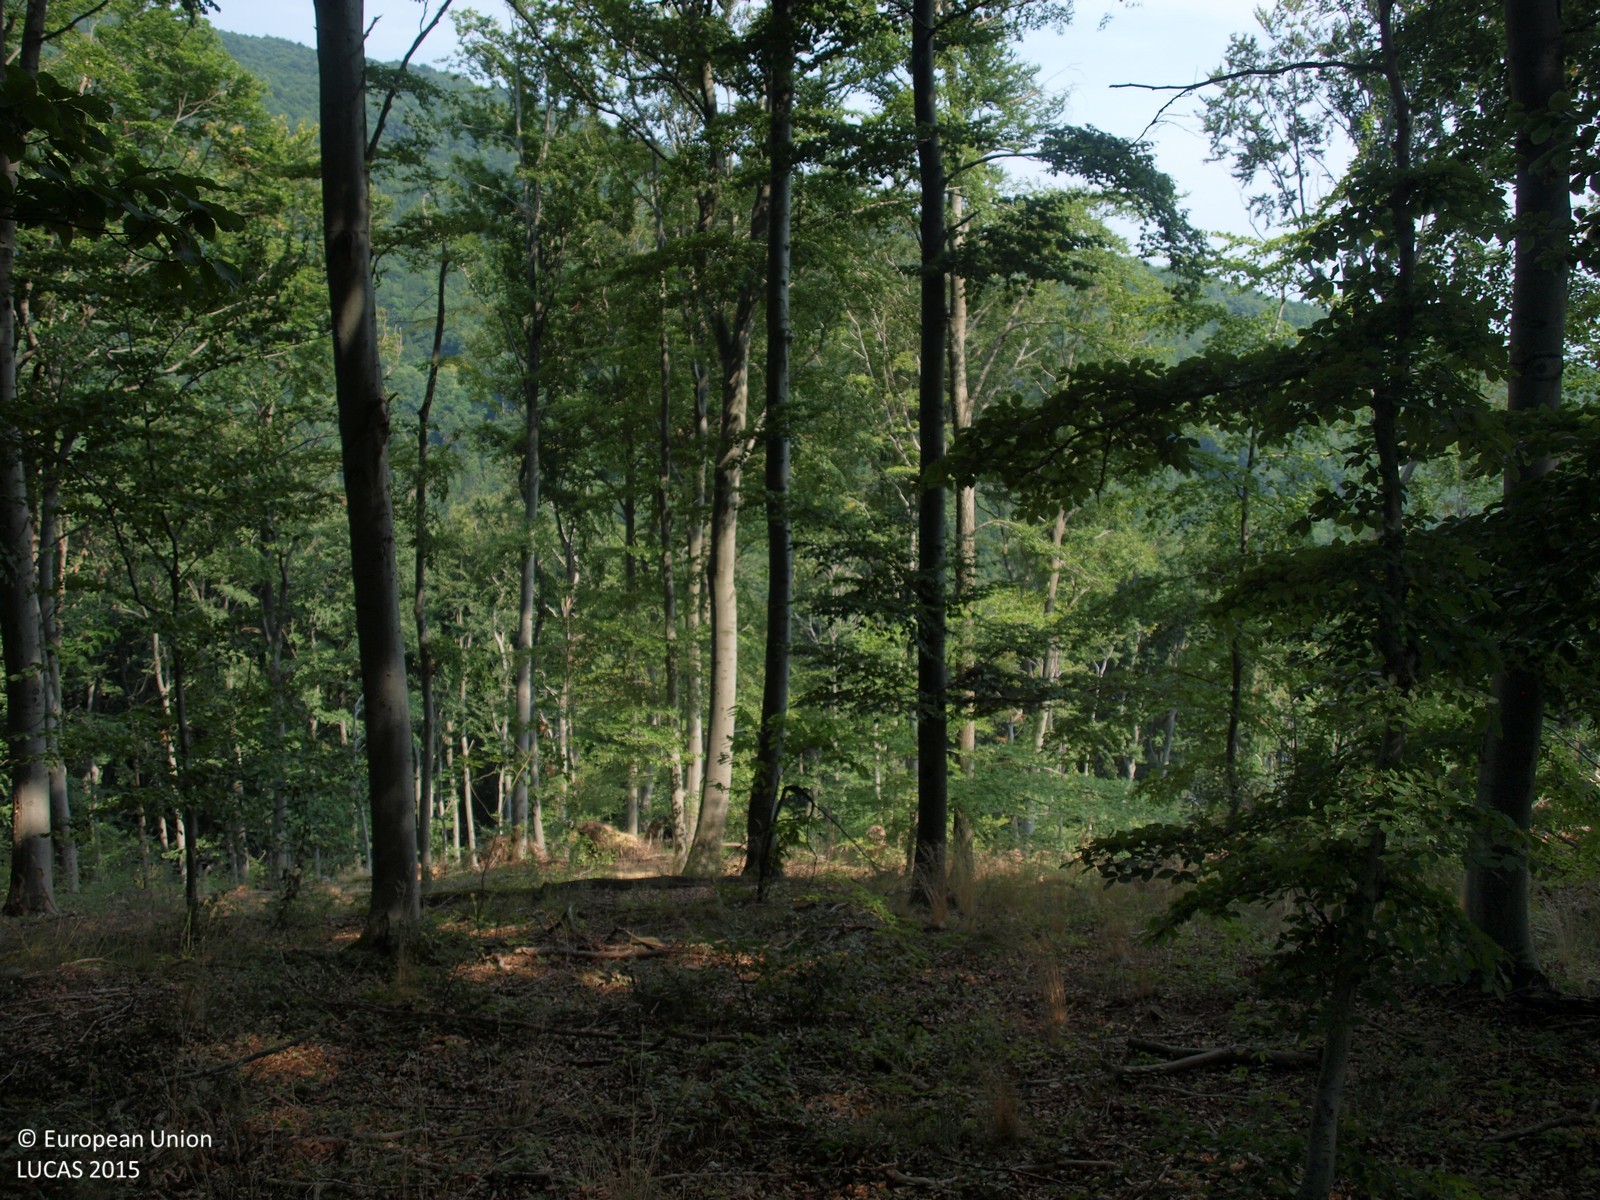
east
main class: Woodland
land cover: Broadleaved woodland
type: beech forest
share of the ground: > 75 %
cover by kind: broadleaved forest trees 100 %
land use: Forestry
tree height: > 5 m
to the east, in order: Broadleaved woodland; Tracks; Broadleaved woodland; Tracks; Broadleaved woodland; Tracks; Broadleaved woodland; Tracks; Broadleaved woodland; Tracks; Broadleaved woodland; Rivers and streams; Broadleaved woodland
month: August
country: HR
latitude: 45.8792
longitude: 15.9377
